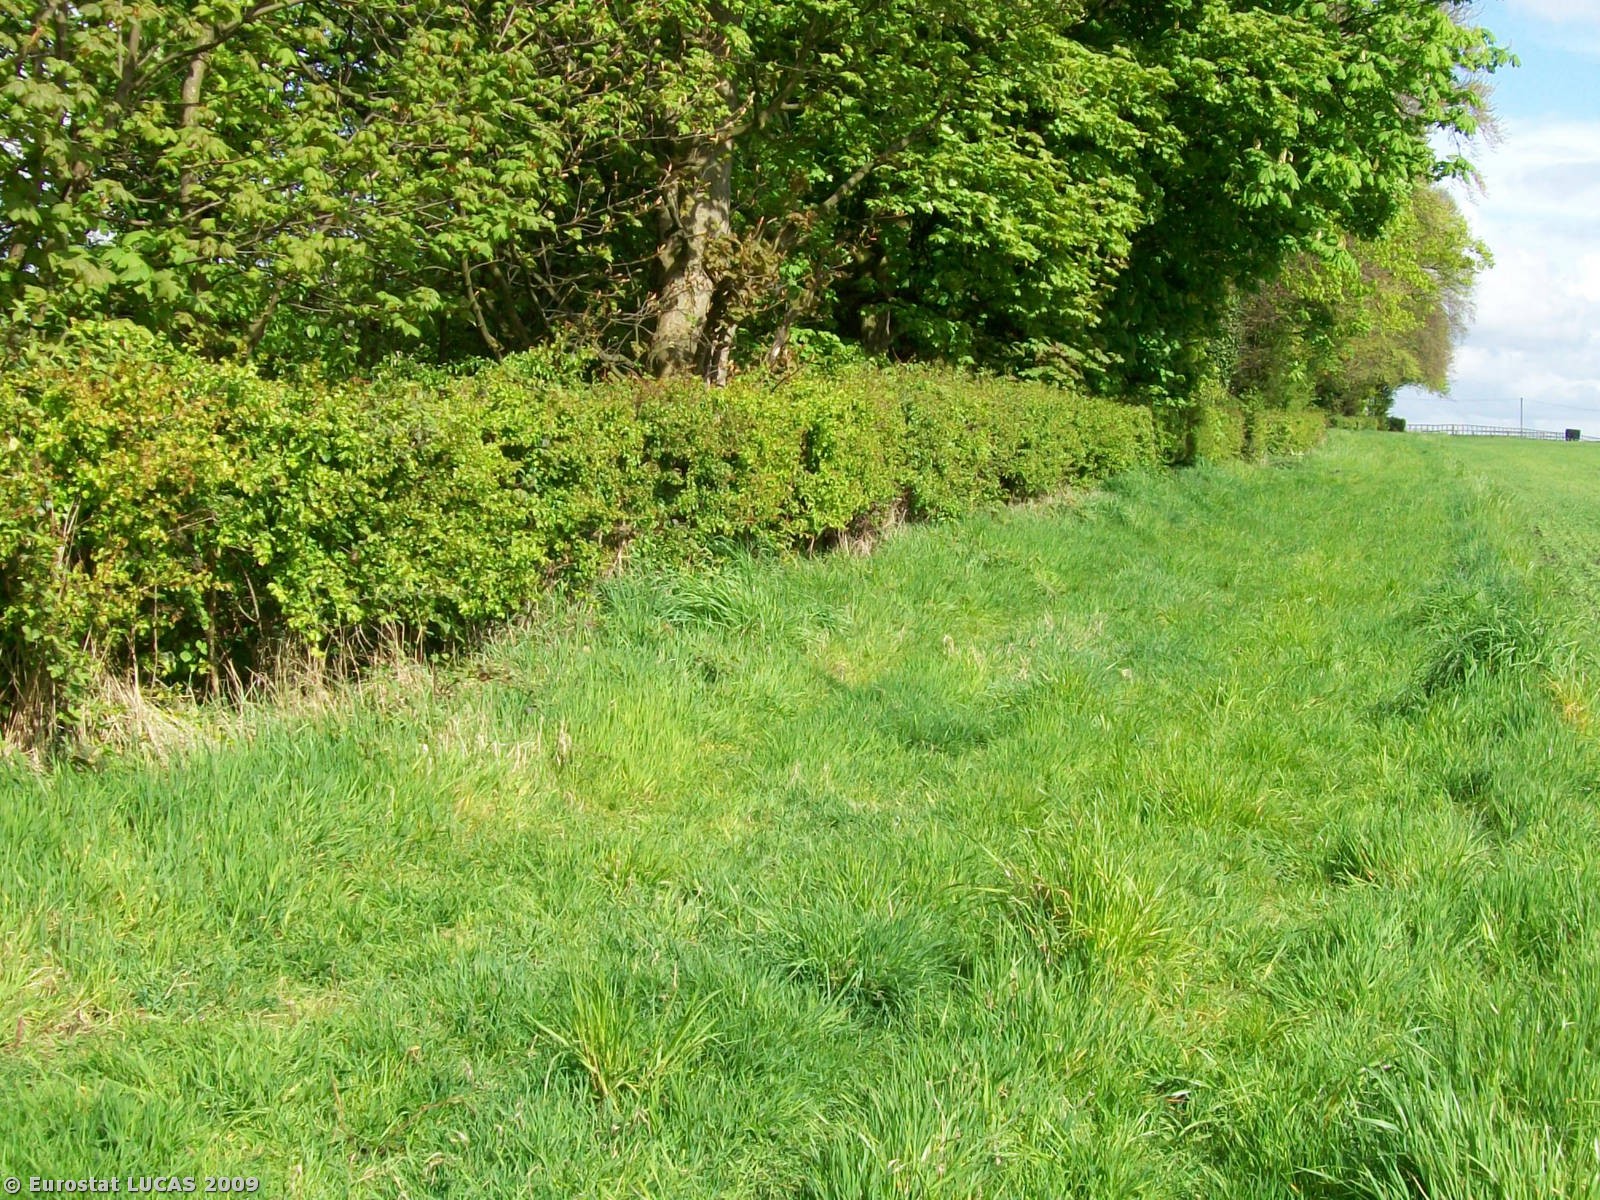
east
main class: Cropland
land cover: Barley
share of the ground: 50 - 75 %
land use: Agriculture (excluding fallow land and kitchen gardens)
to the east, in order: Barley; Grass margins; Fences; Grassland without tree/shrub cover
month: April
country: GB
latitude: 53.5044
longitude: -2.7802
